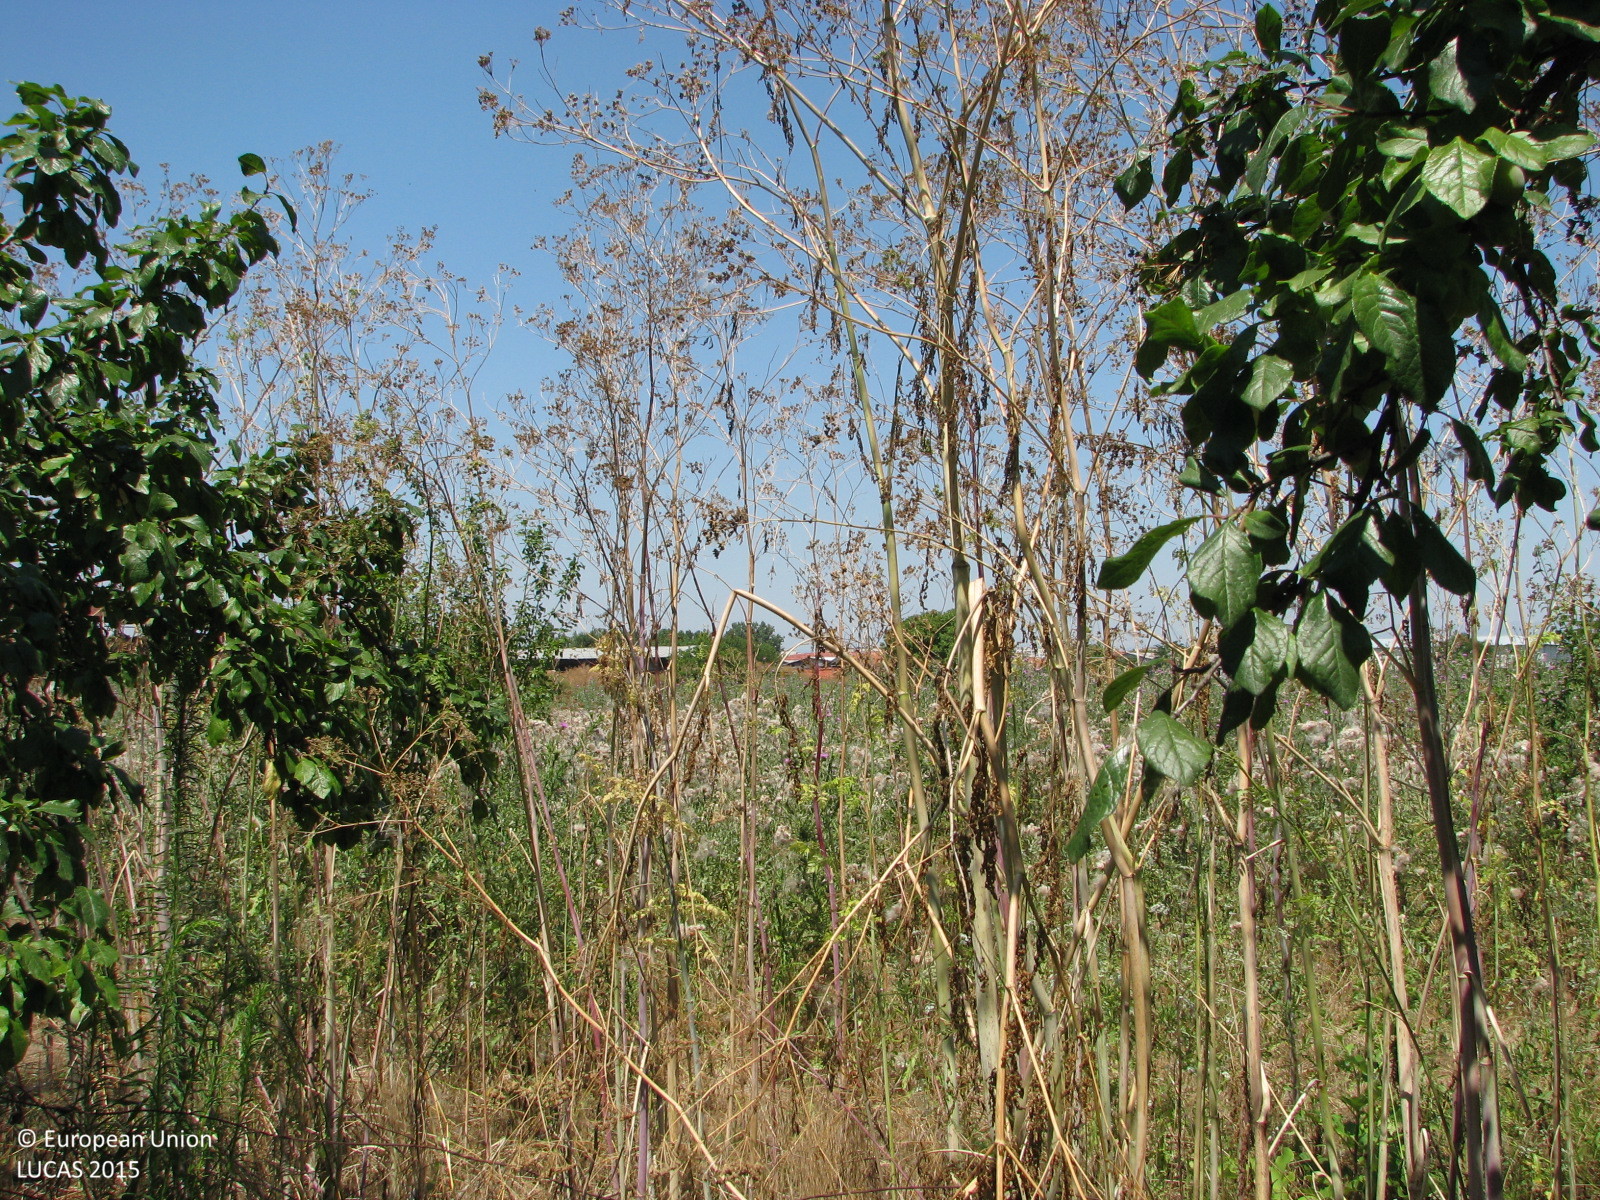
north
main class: Cropland
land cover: Other fruit trees and berries
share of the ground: 50 - 75 %
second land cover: Spontaneously vegetated surfaces
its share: 25 - 50 %
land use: Abandoned areas
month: July
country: BG
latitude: 42.4672
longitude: 26.4986
